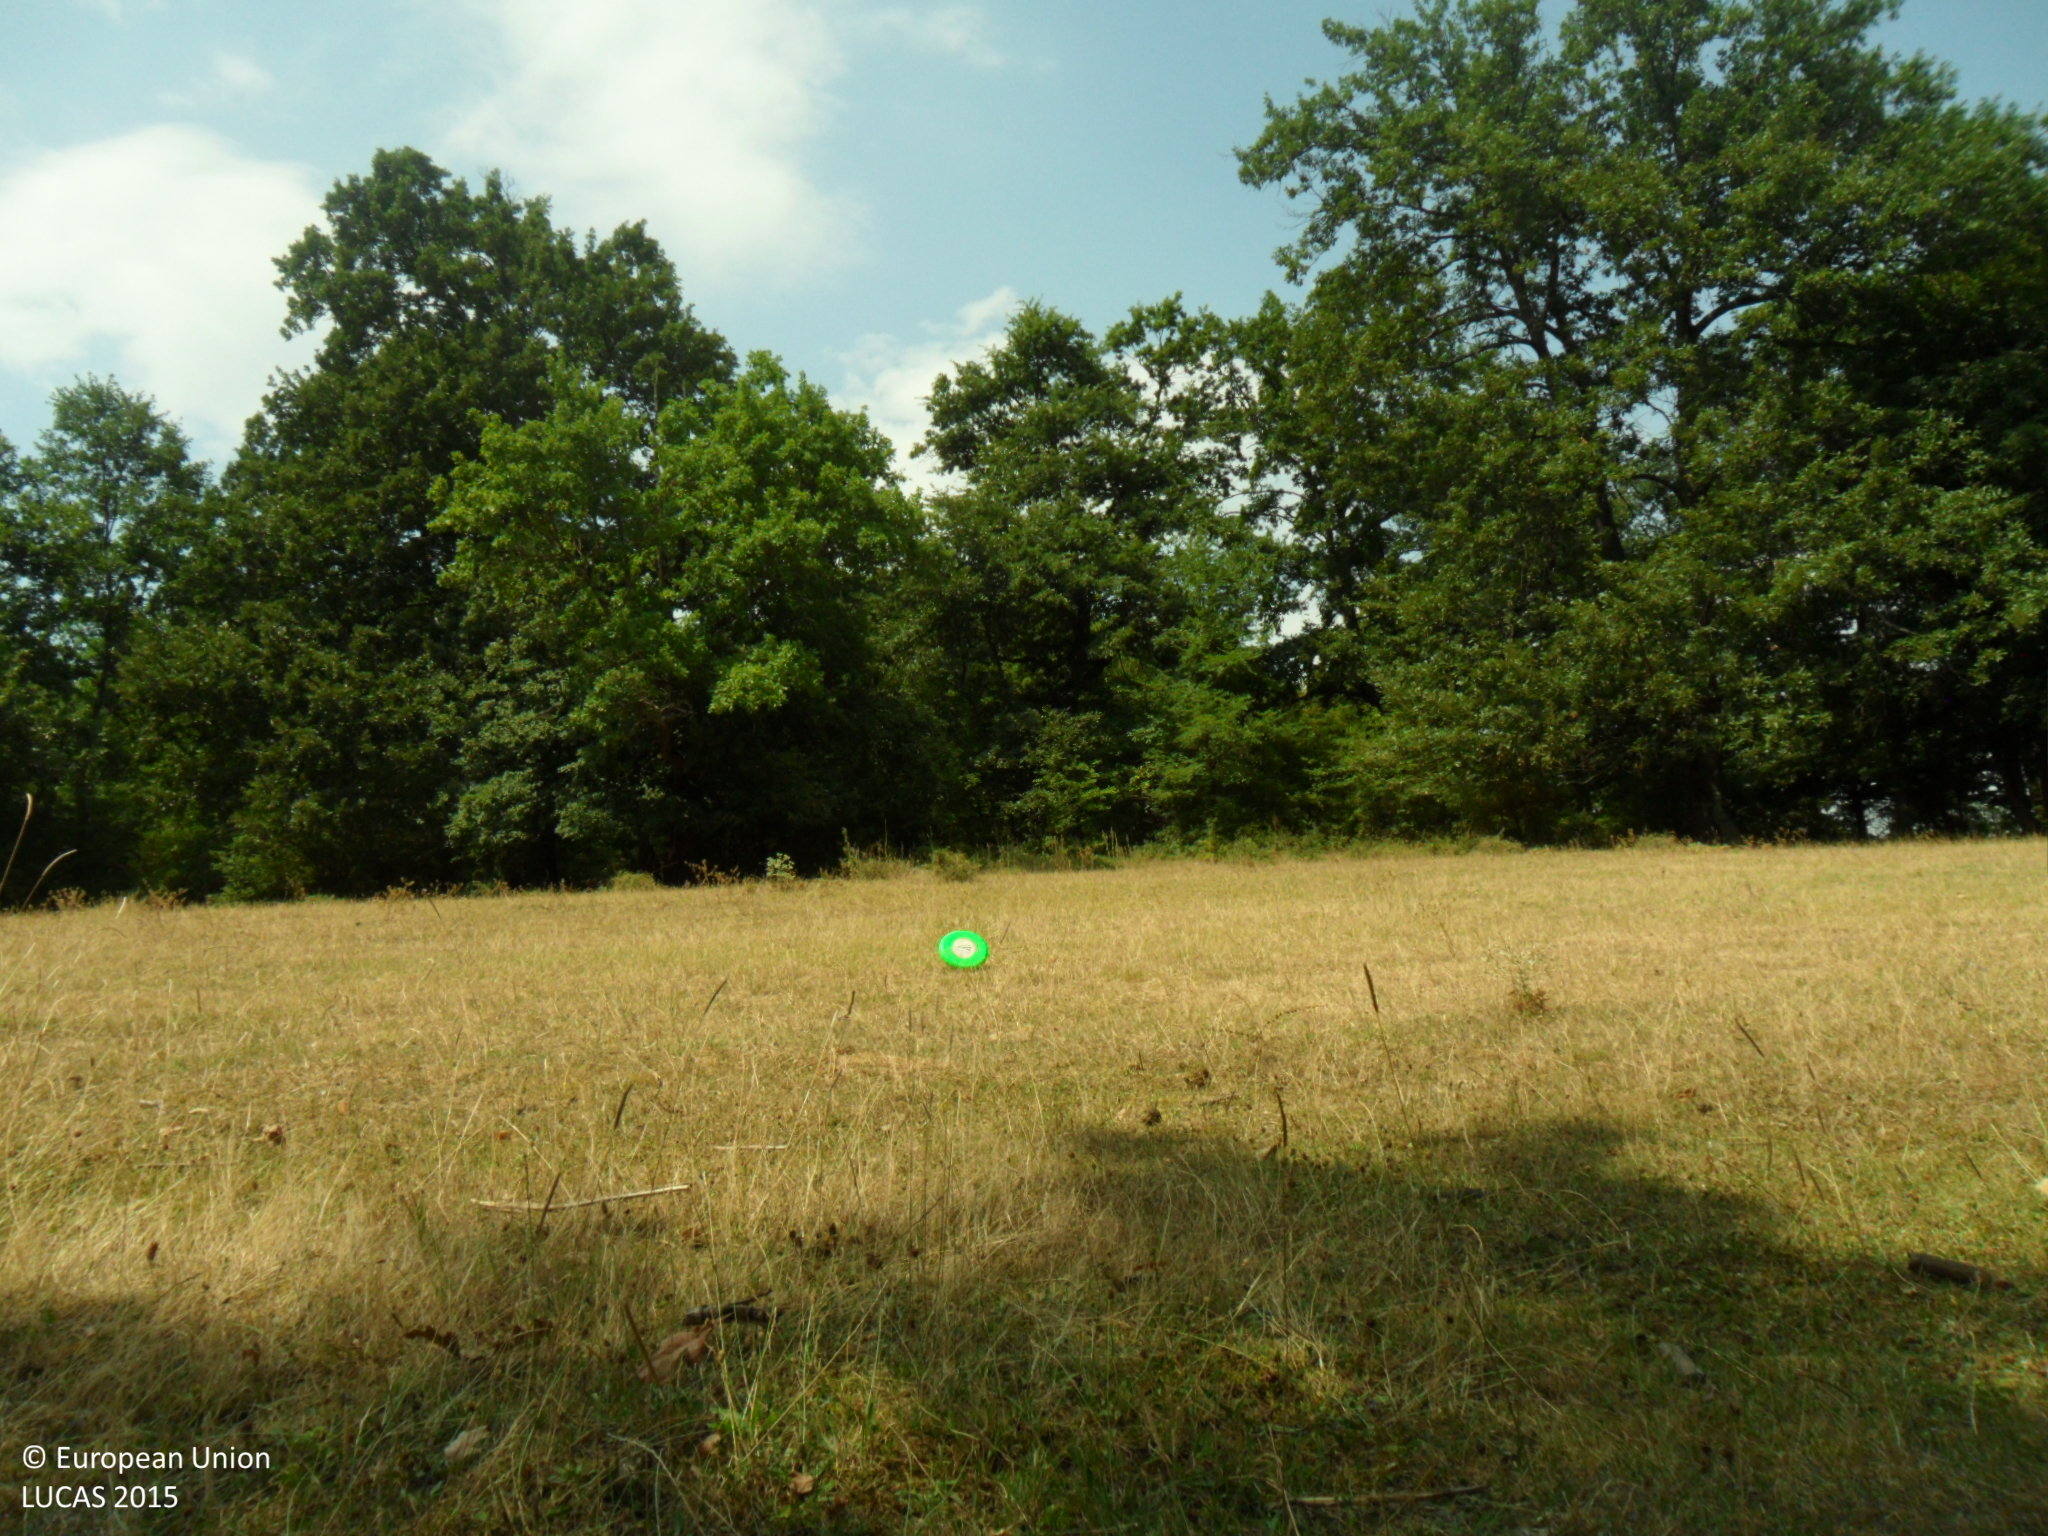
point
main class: Grassland
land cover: Grassland without tree/shrub cover
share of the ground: > 75 %
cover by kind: herbaceous plants 100 %
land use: Agriculture (excluding fallow land and kitchen gardens)
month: August
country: BG
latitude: 43.0348
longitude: 26.7357
